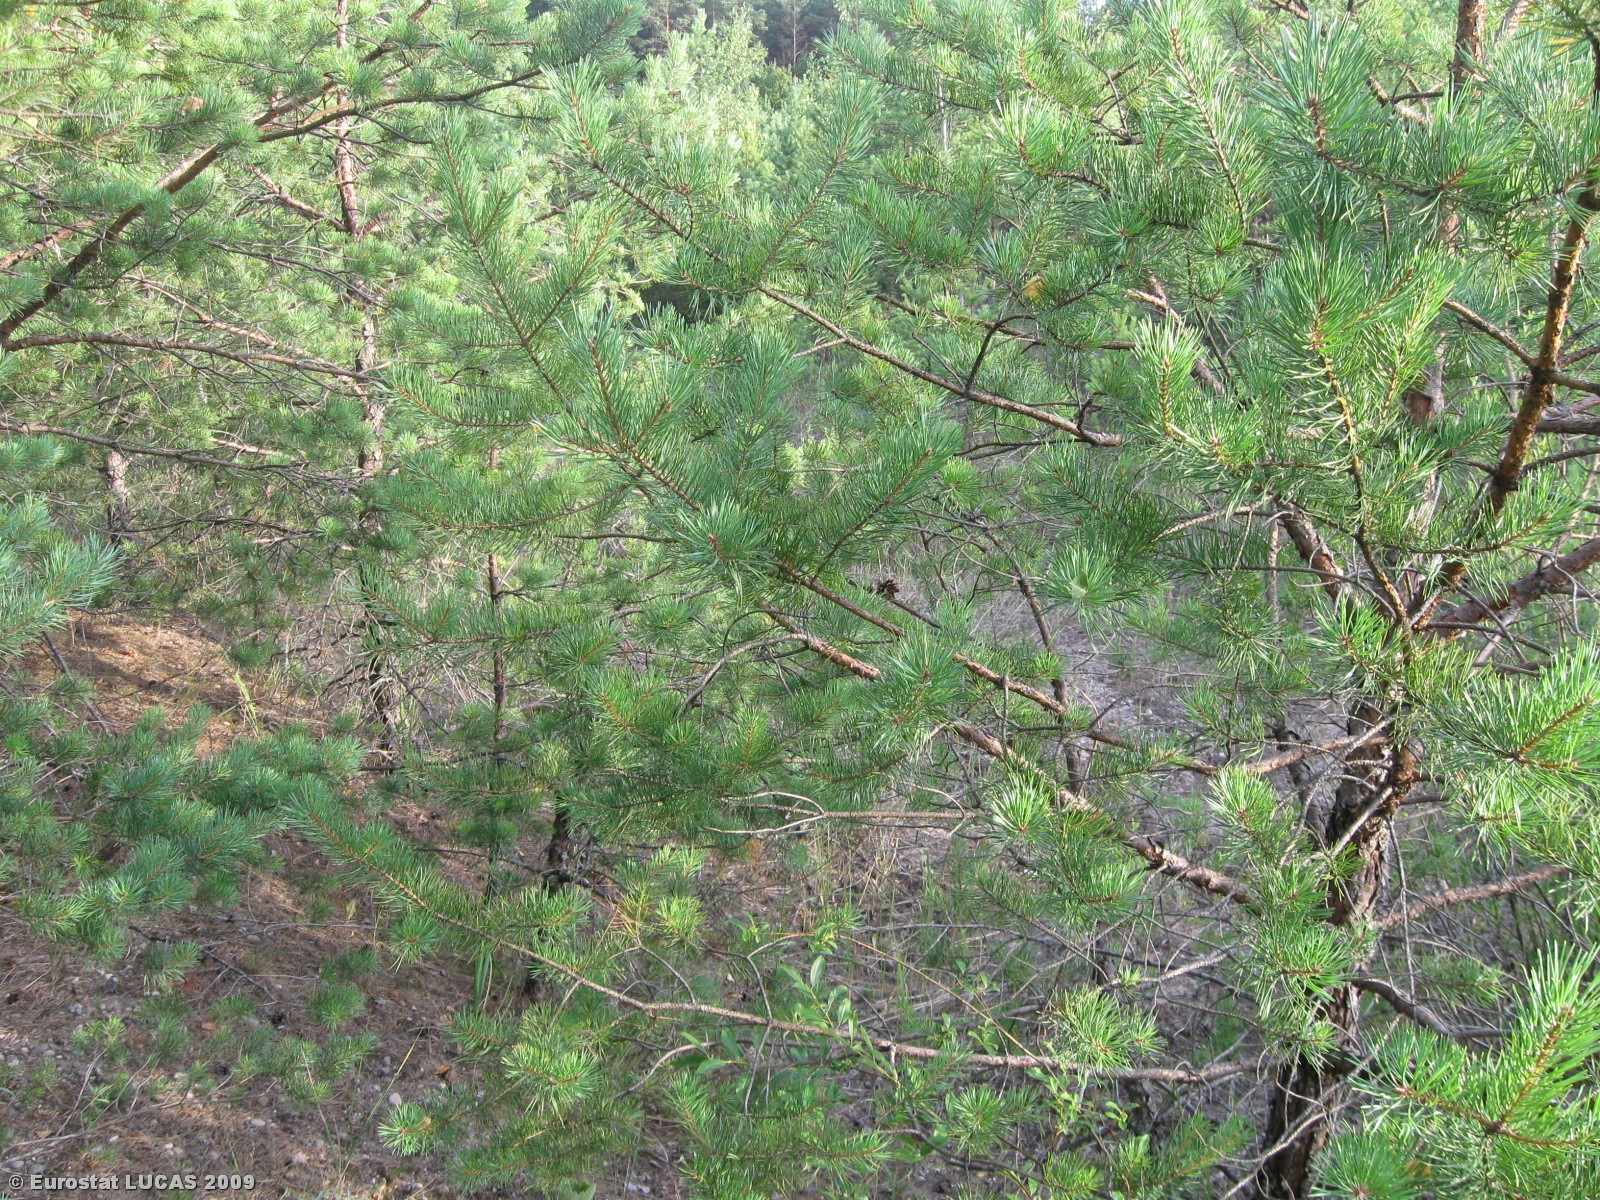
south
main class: Woodland
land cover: Mixed woodland
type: hemiboreal forest and nemoral coniferous forest and mixed broadleaved-coniferous forest
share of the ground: > 75 %
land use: Forestry
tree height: > 5 m
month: August
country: LT
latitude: 55.0853
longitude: 22.6447
